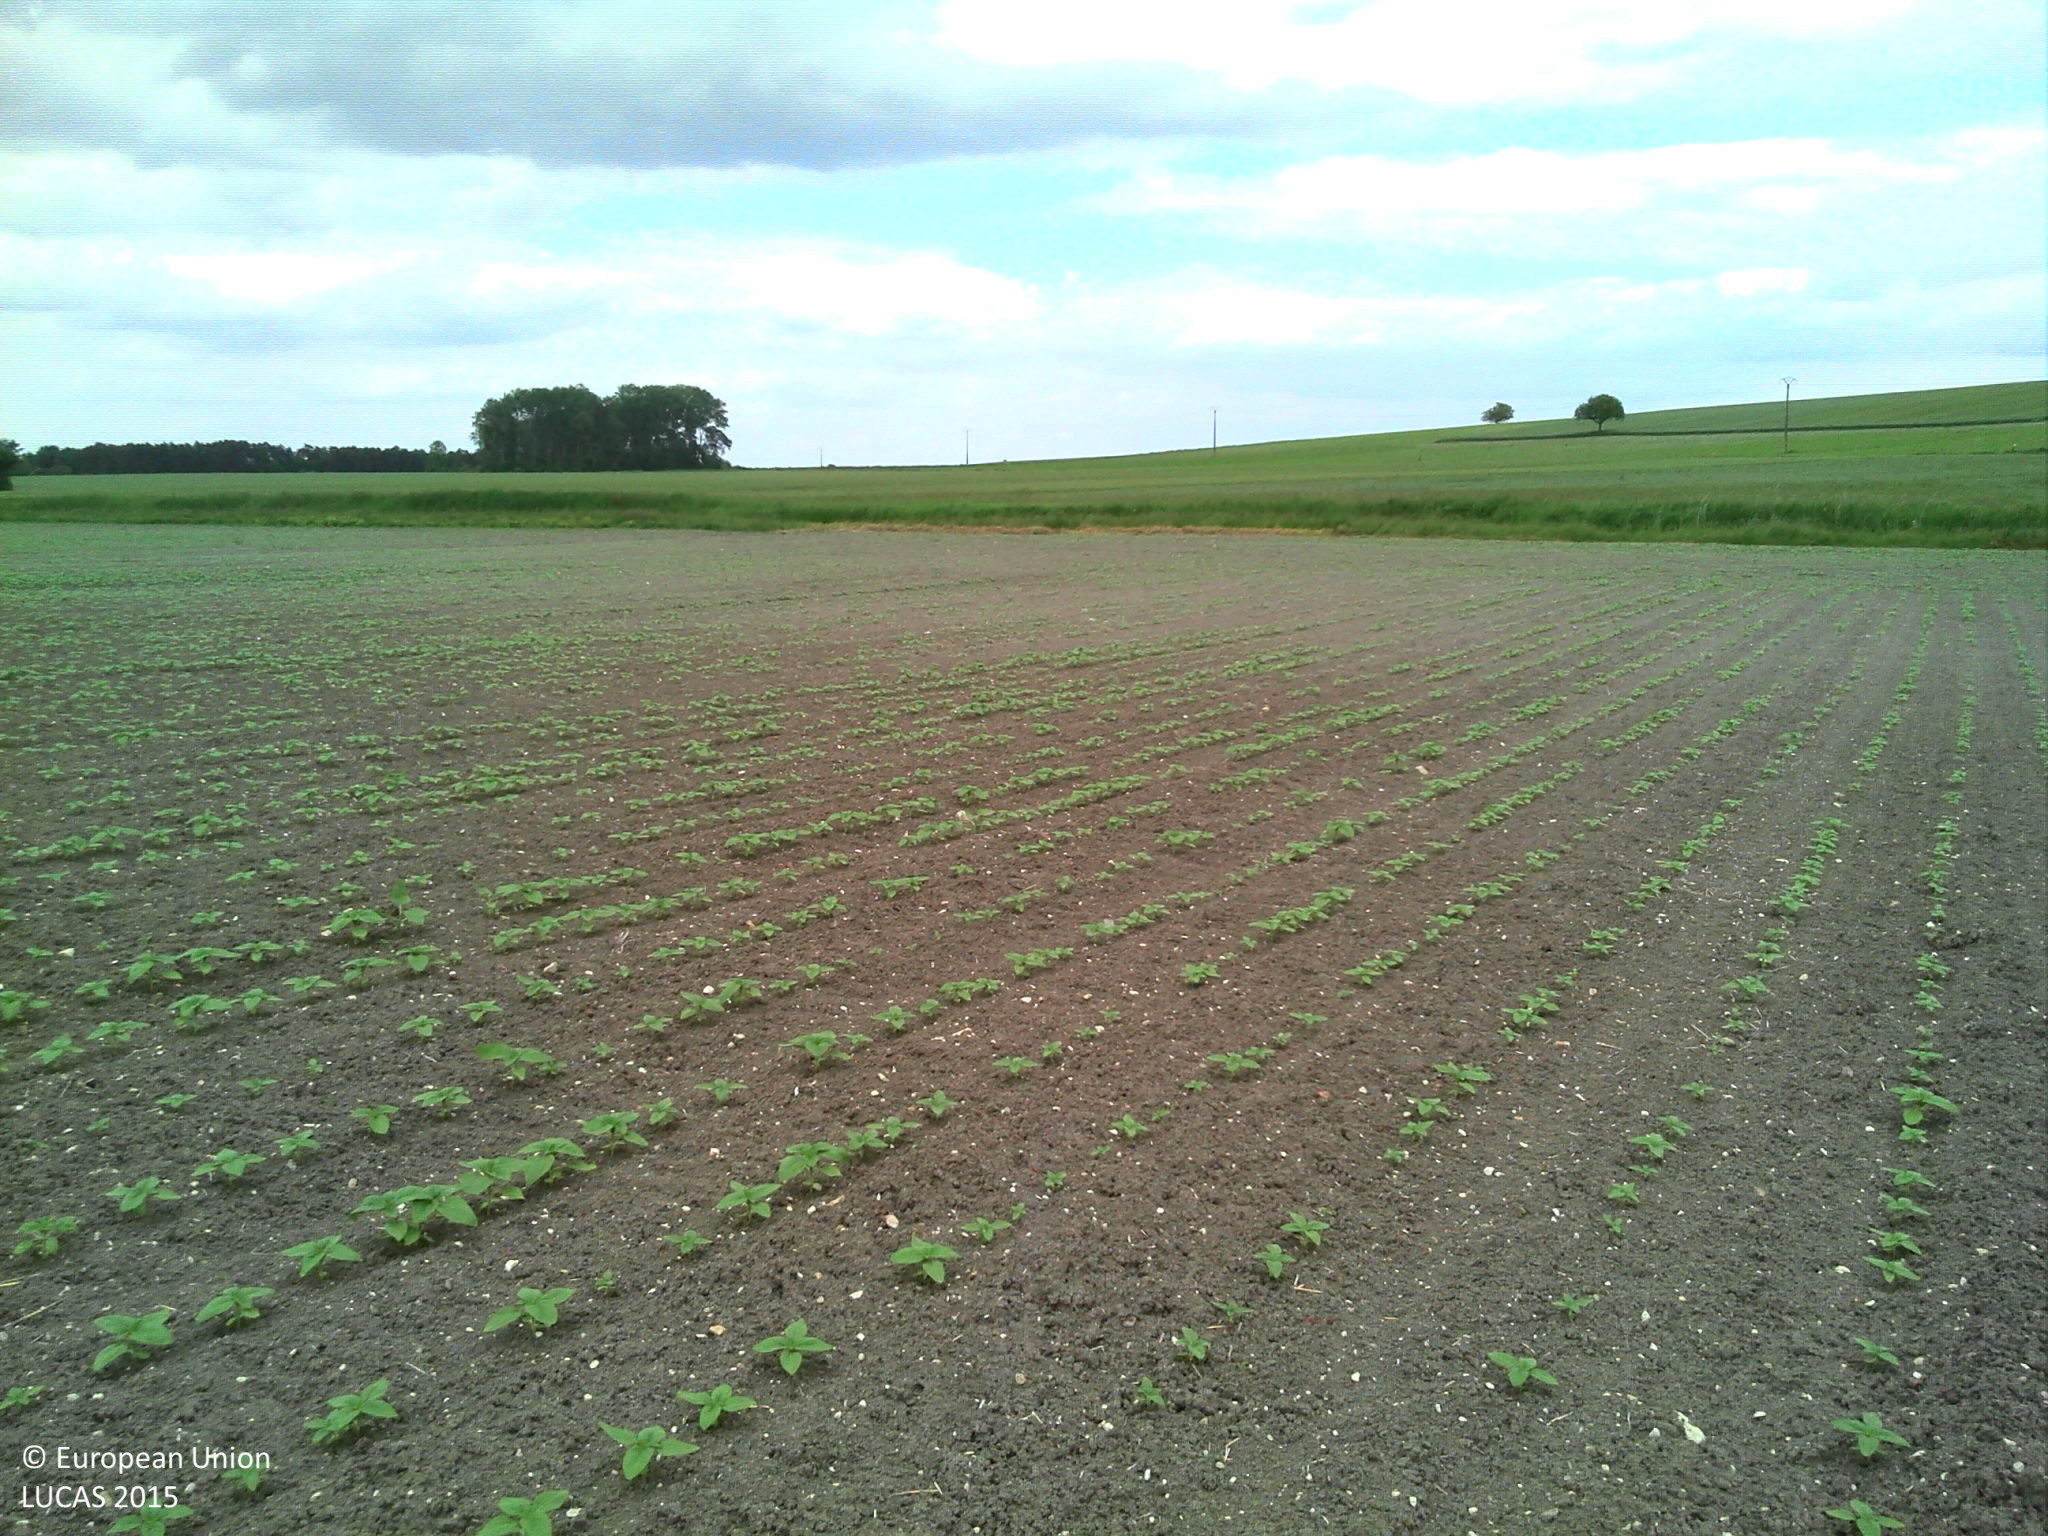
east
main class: Cropland
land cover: Sunflower
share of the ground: 10 - 25 %
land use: Agriculture (excluding fallow land and kitchen gardens)
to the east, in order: Sunflower; Grassland without tree/shrub cover; Ditches and canals; Grassland without tree/shrub cover; Common wheat
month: May
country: FR
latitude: 46.7929
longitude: 0.2454
